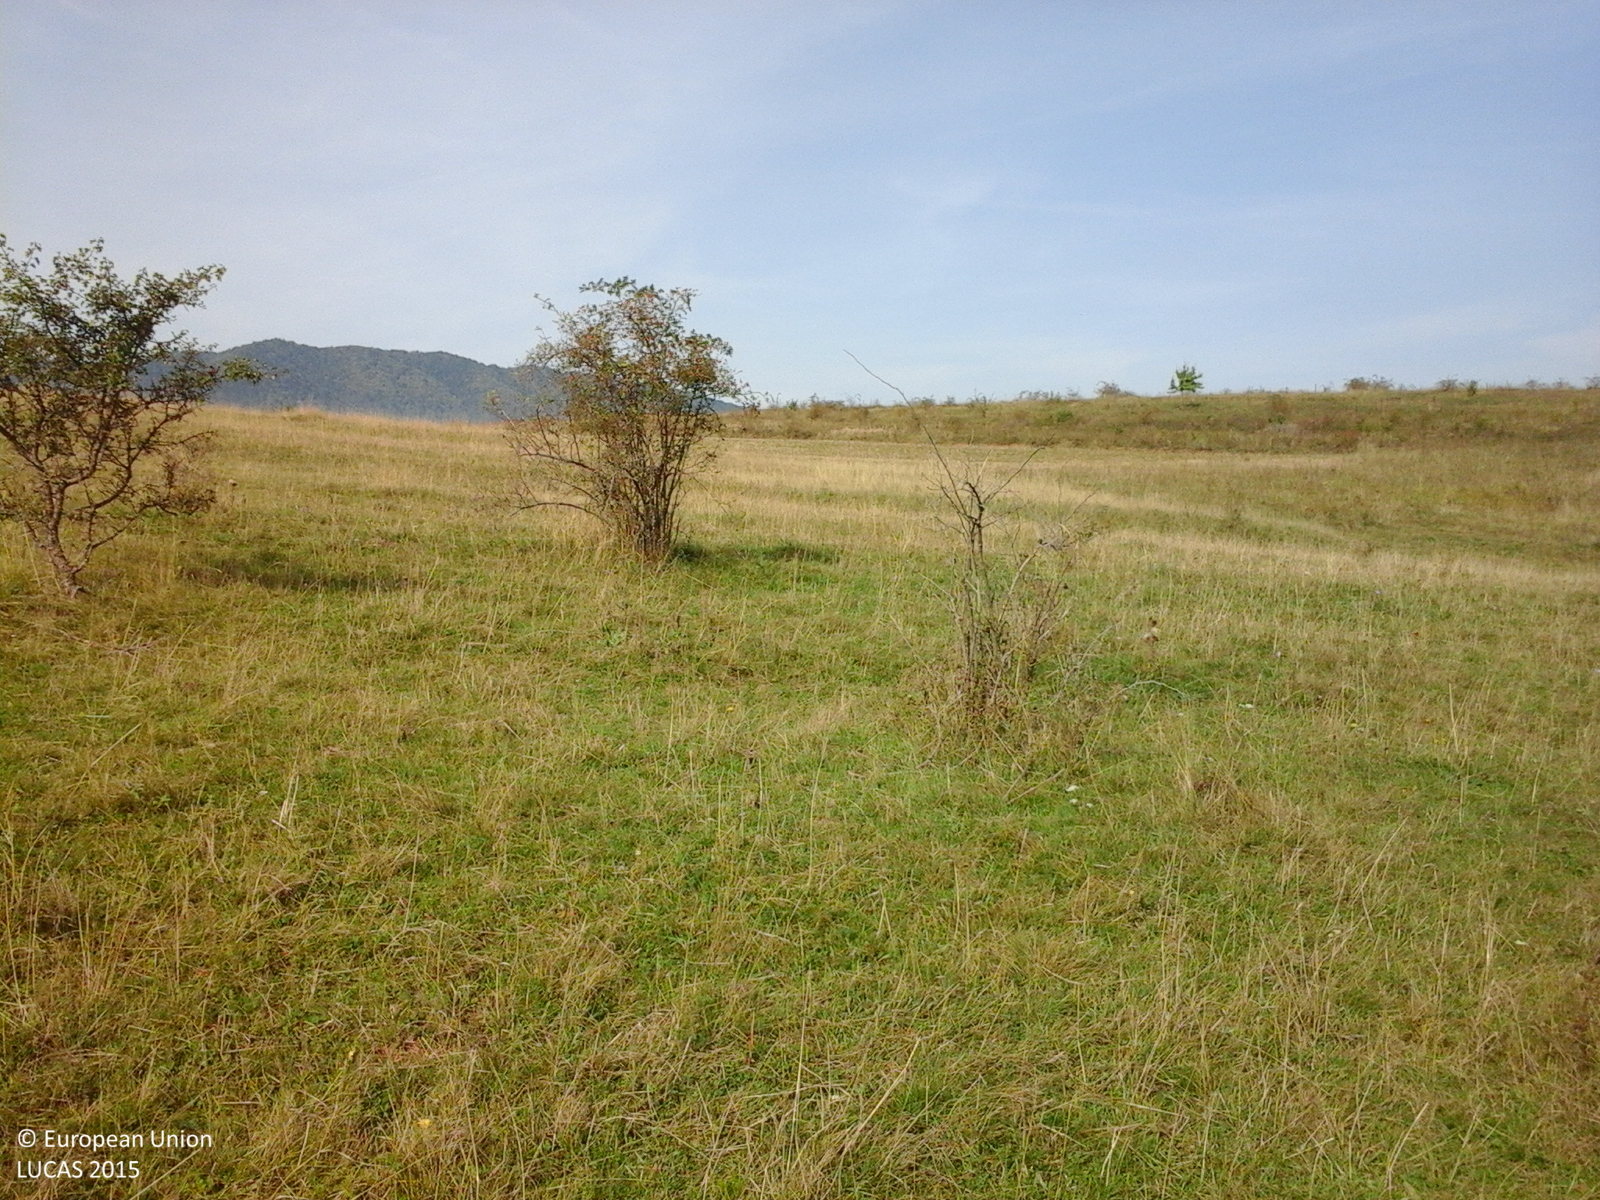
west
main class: Grassland
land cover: Grassland with sparse tree/shrub cover
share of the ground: > 75 %
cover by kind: herbaceous plants 90 %, broadleaved forest trees 5 %, shrubs 5 %
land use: Agriculture (excluding fallow land and kitchen gardens)
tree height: < 5 m
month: September
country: RO
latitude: 46.8155
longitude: 22.9702
